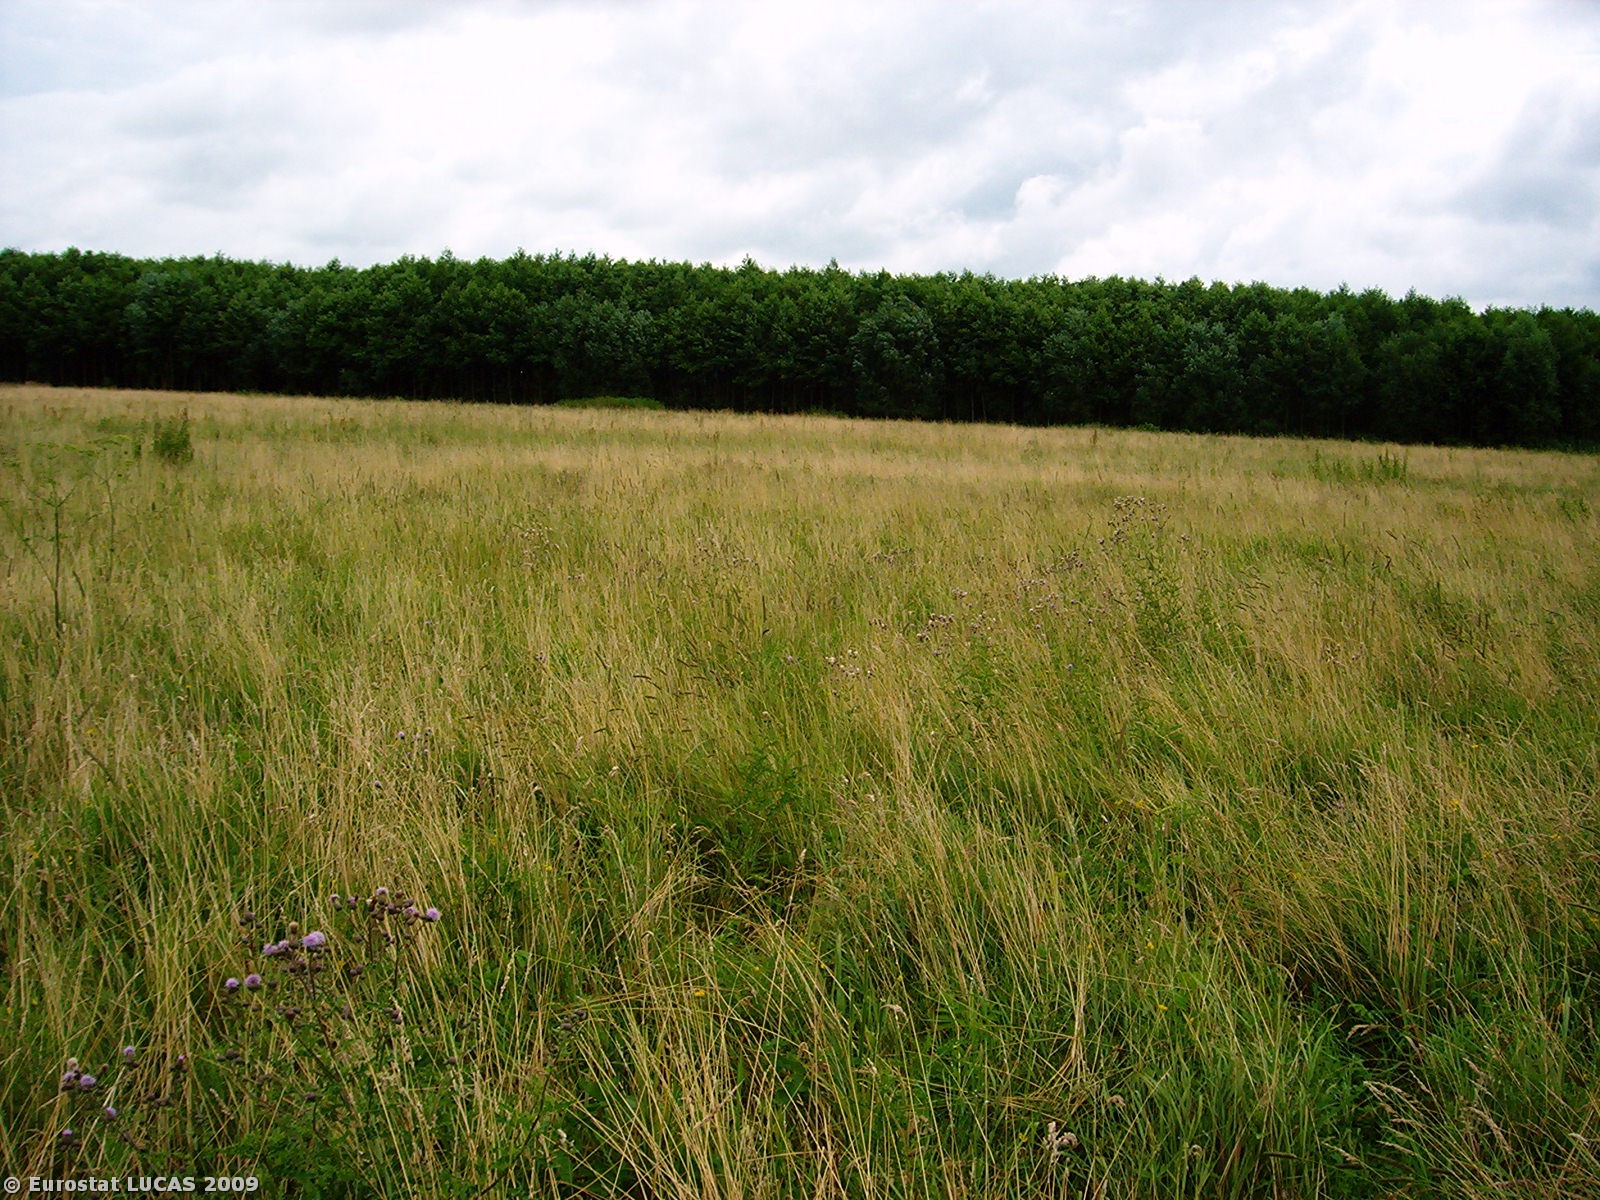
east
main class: Grassland
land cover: Grassland without tree/shrub cover
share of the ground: > 75 %
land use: Agriculture (excluding fallow land and kitchen gardens)
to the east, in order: Grassland without tree/shrub cover; Ditches and canals; Broadleaved woodland
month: July
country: PL
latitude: 52.6410
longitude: 15.2198
